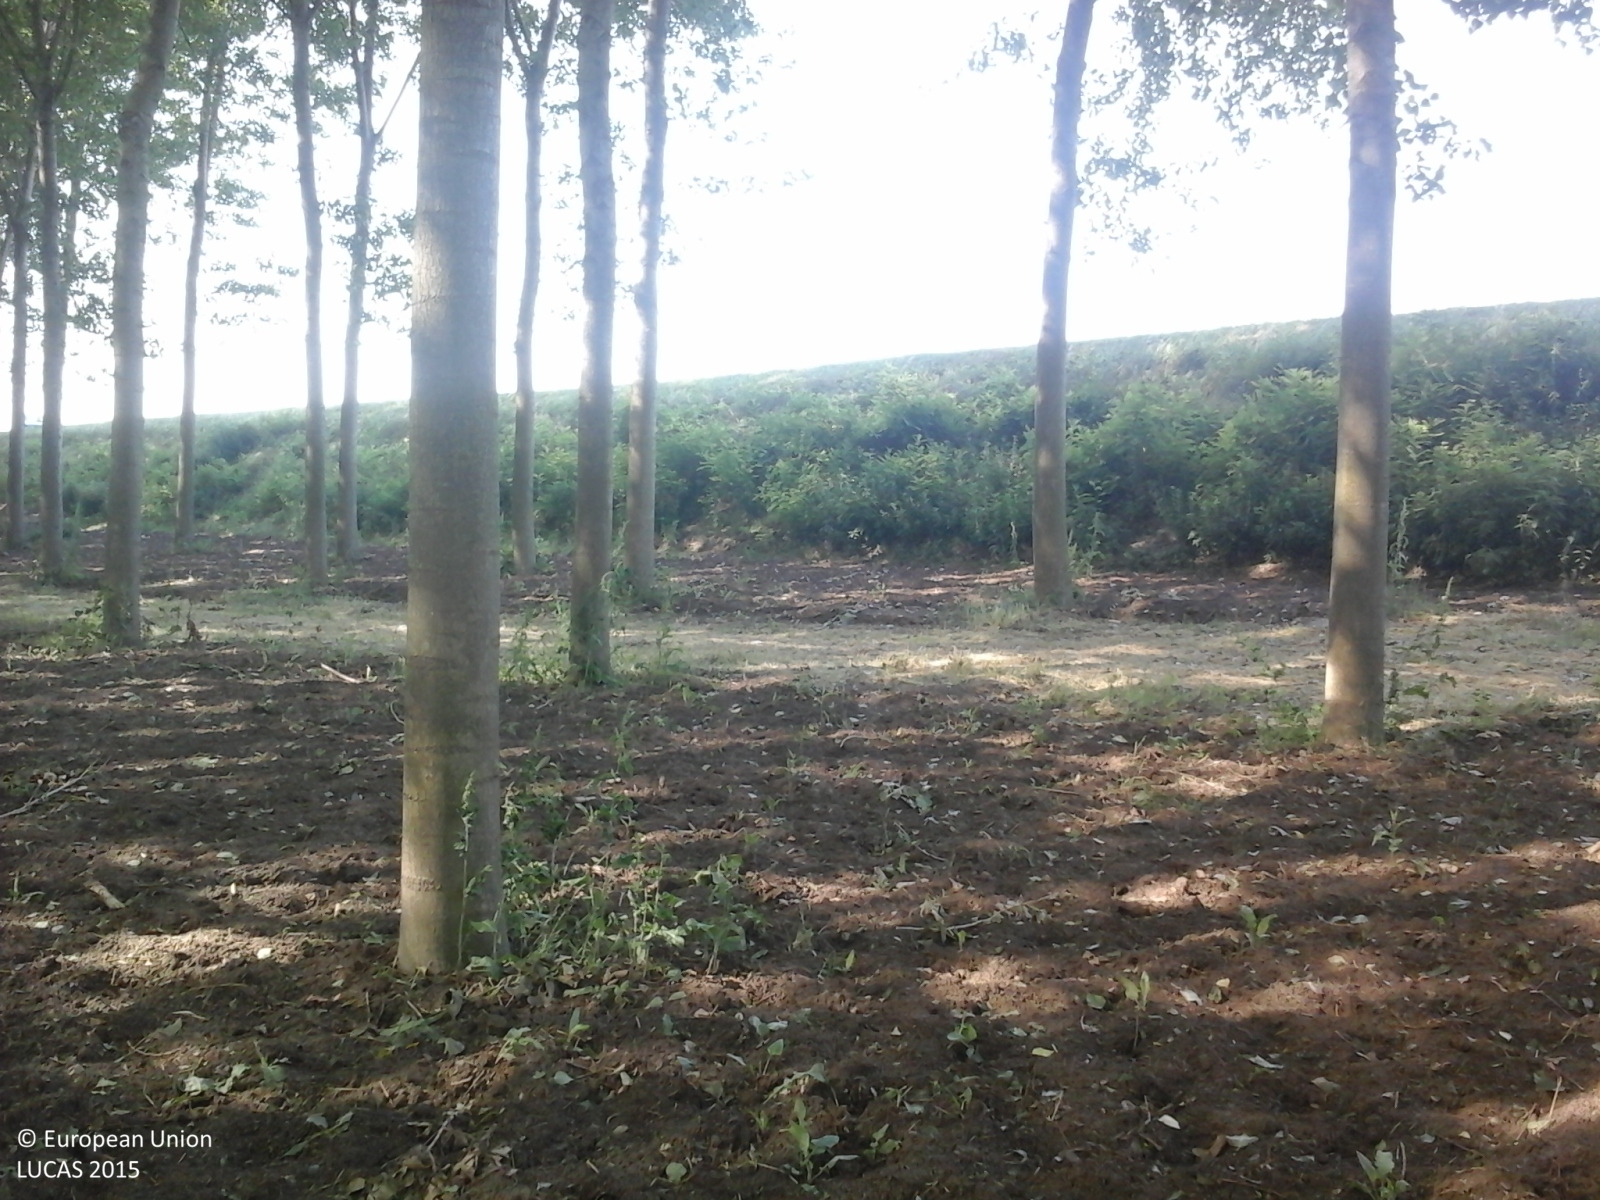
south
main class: Woodland
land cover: Broadleaved woodland
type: non-riverine alder, birch or aspen forest
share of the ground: > 75 %
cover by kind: broadleaved forest trees 100 %
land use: Forestry
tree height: > 5 m
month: May
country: IT
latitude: 45.1063
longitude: 10.5708
